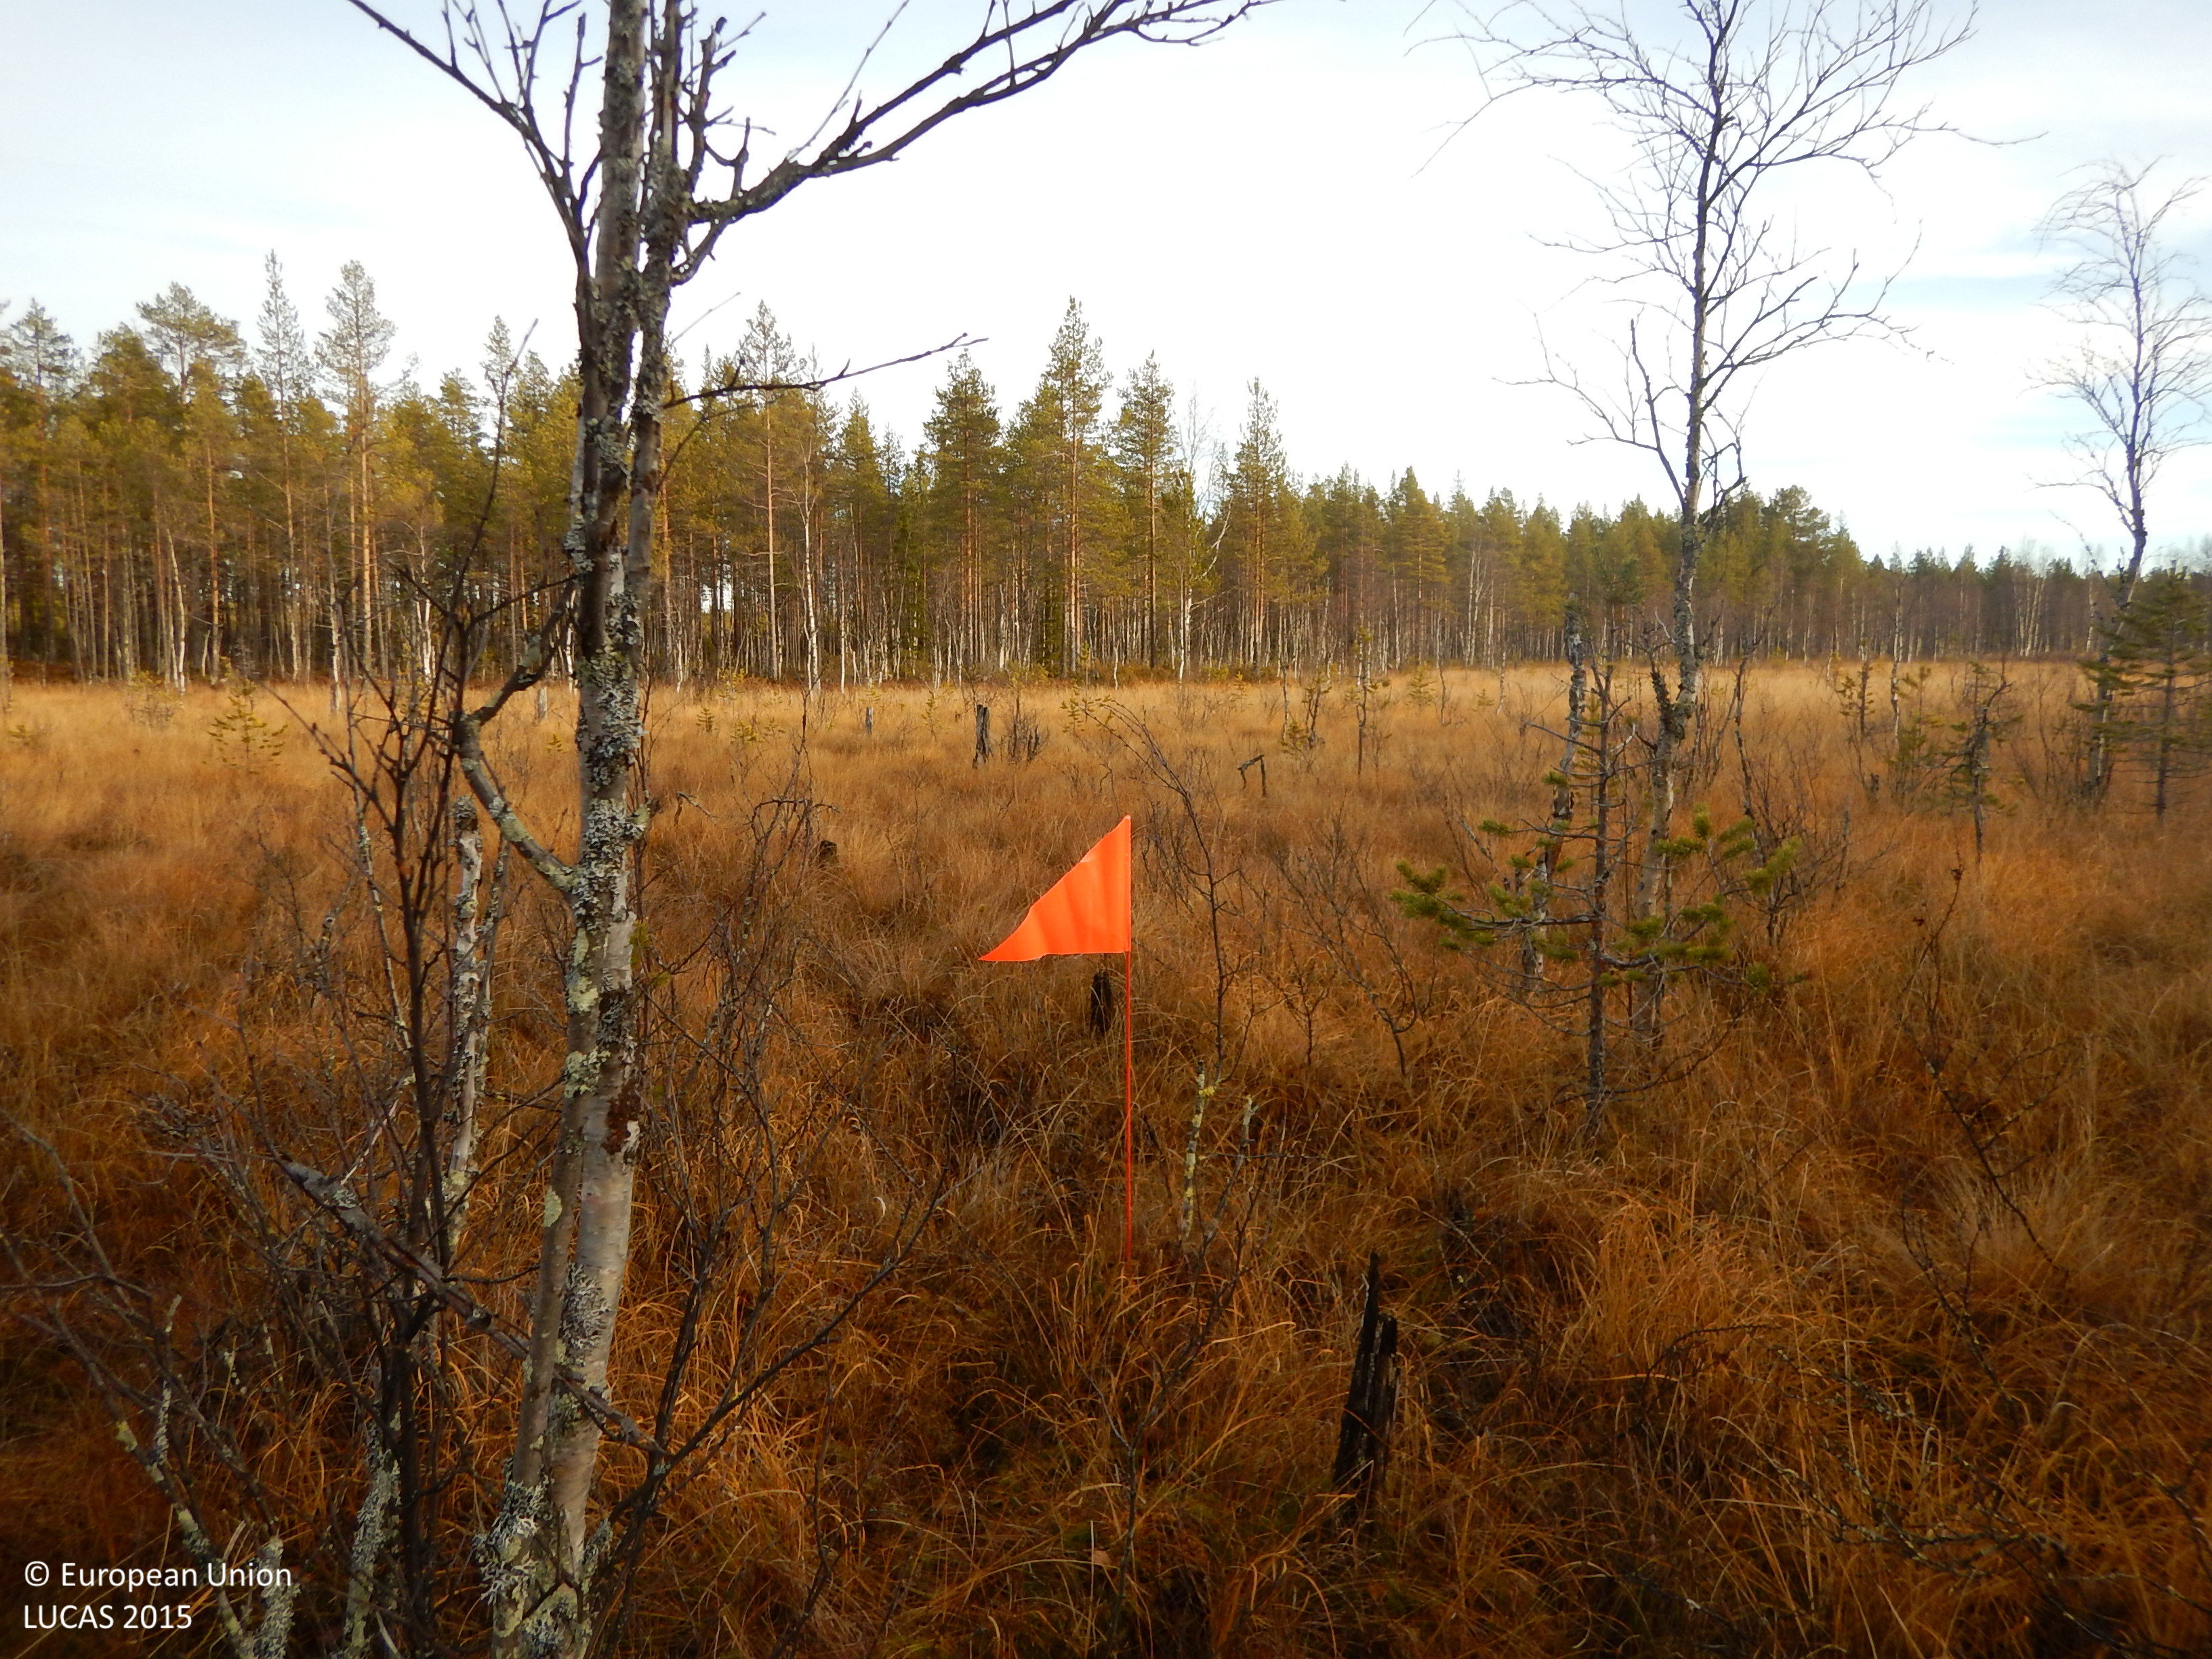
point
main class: Woodland
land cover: Pine dominated mixed woodland
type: mire and swamp forests
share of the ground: 10 - 25 %
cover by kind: herbaceous plants 60 %, coniferous forest trees 10 %, broadleaved forest trees 10 %, shrubs 10 %, lichens and mosses 10 %
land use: Semi-natural and natural areas not in use
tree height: > 5 m
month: October
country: SE
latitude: 65.3248
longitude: 20.2504
